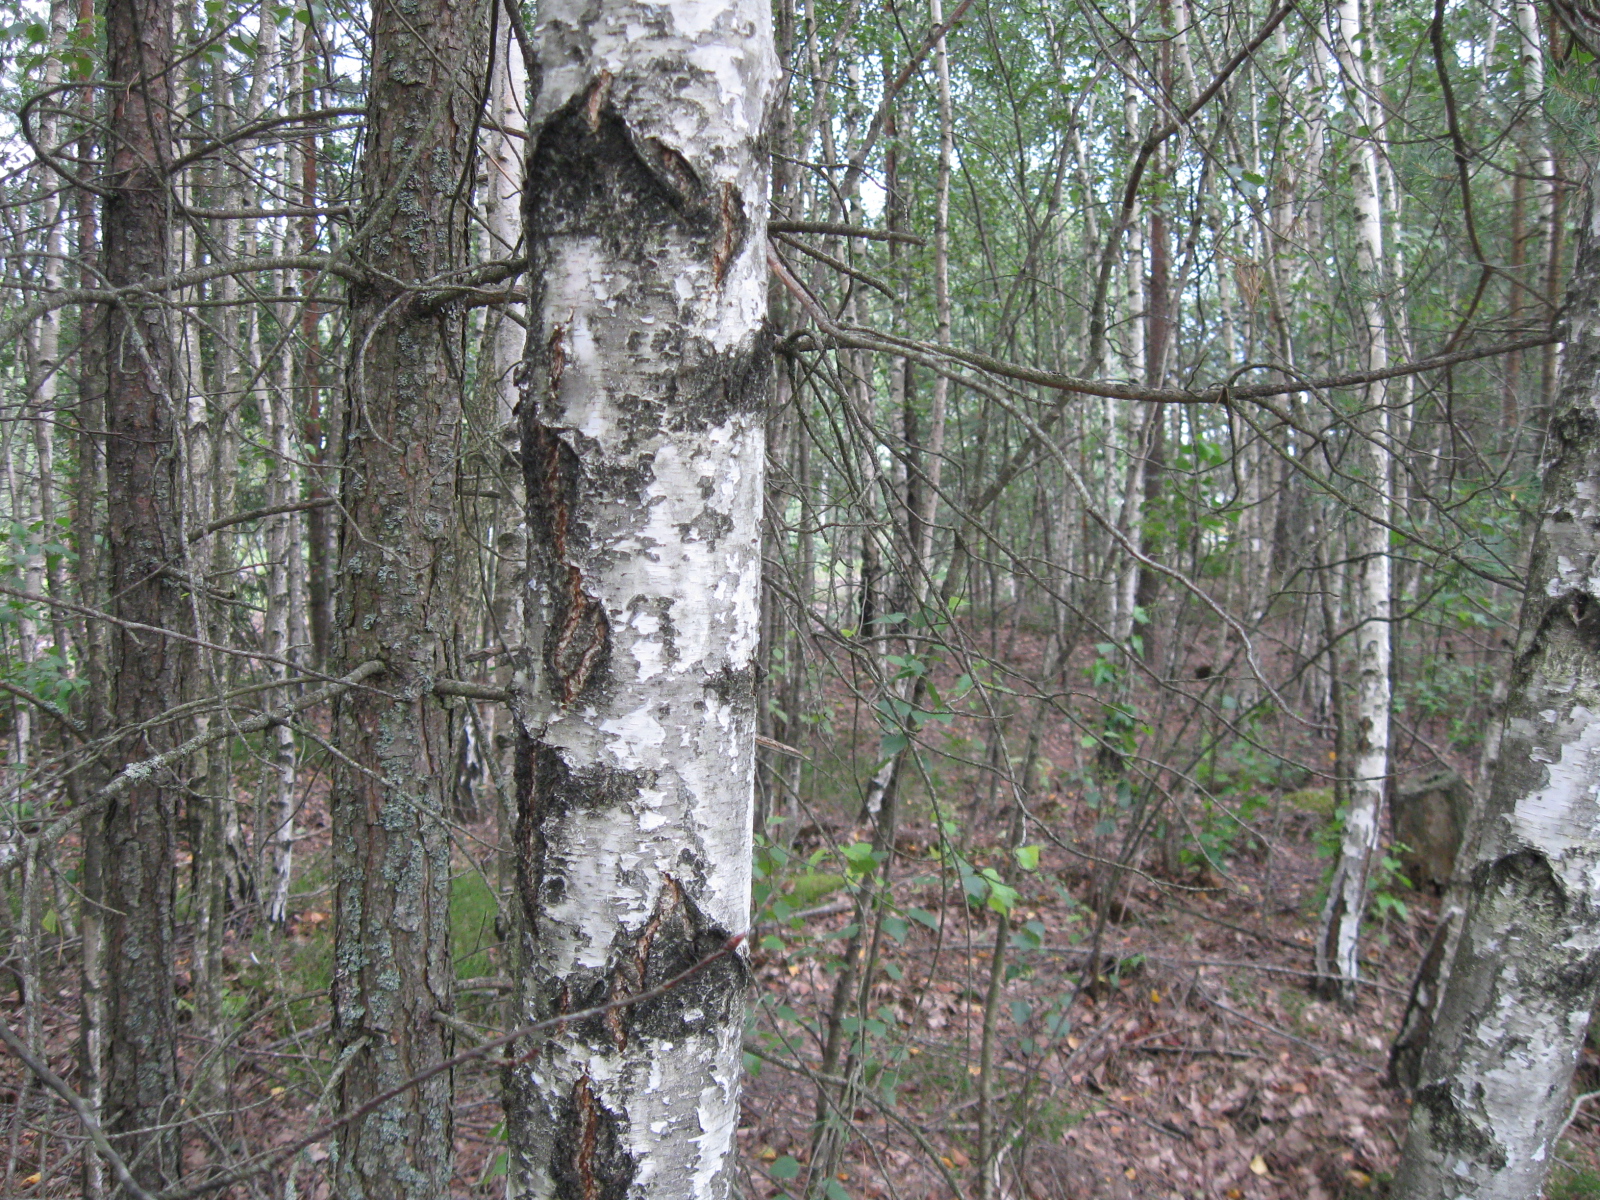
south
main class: Woodland
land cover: Pine dominated mixed woodland
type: mire and swamp forests
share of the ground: > 75 %
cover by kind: broadleaved forest trees 55 %, coniferous forest trees 25 %, herbaceous plants 15 %, shrubs 5 %
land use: Forestry
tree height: > 5 m
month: July
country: LT
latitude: 54.8754
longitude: 23.5947
